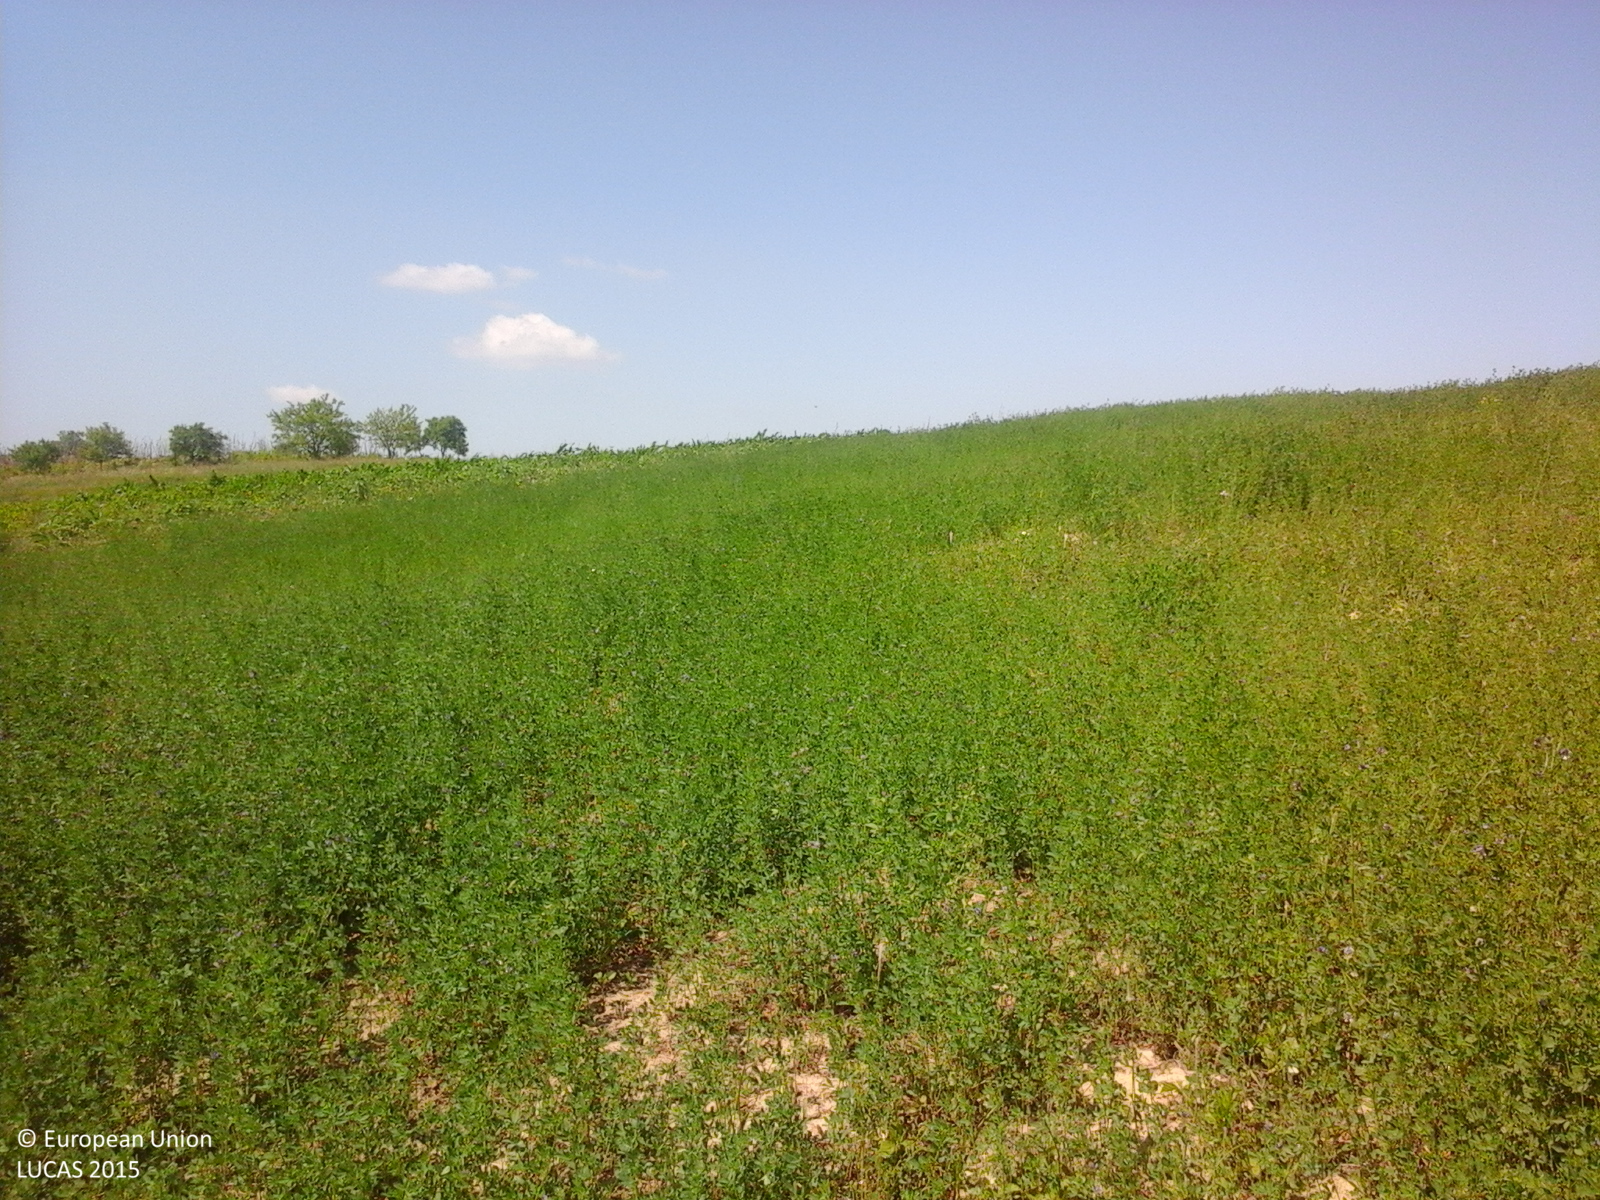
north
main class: Cropland
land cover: Lucerne
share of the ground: > 75 %
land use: Agriculture (excluding fallow land and kitchen gardens)
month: June
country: RO
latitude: 46.7464
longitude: 27.3198
